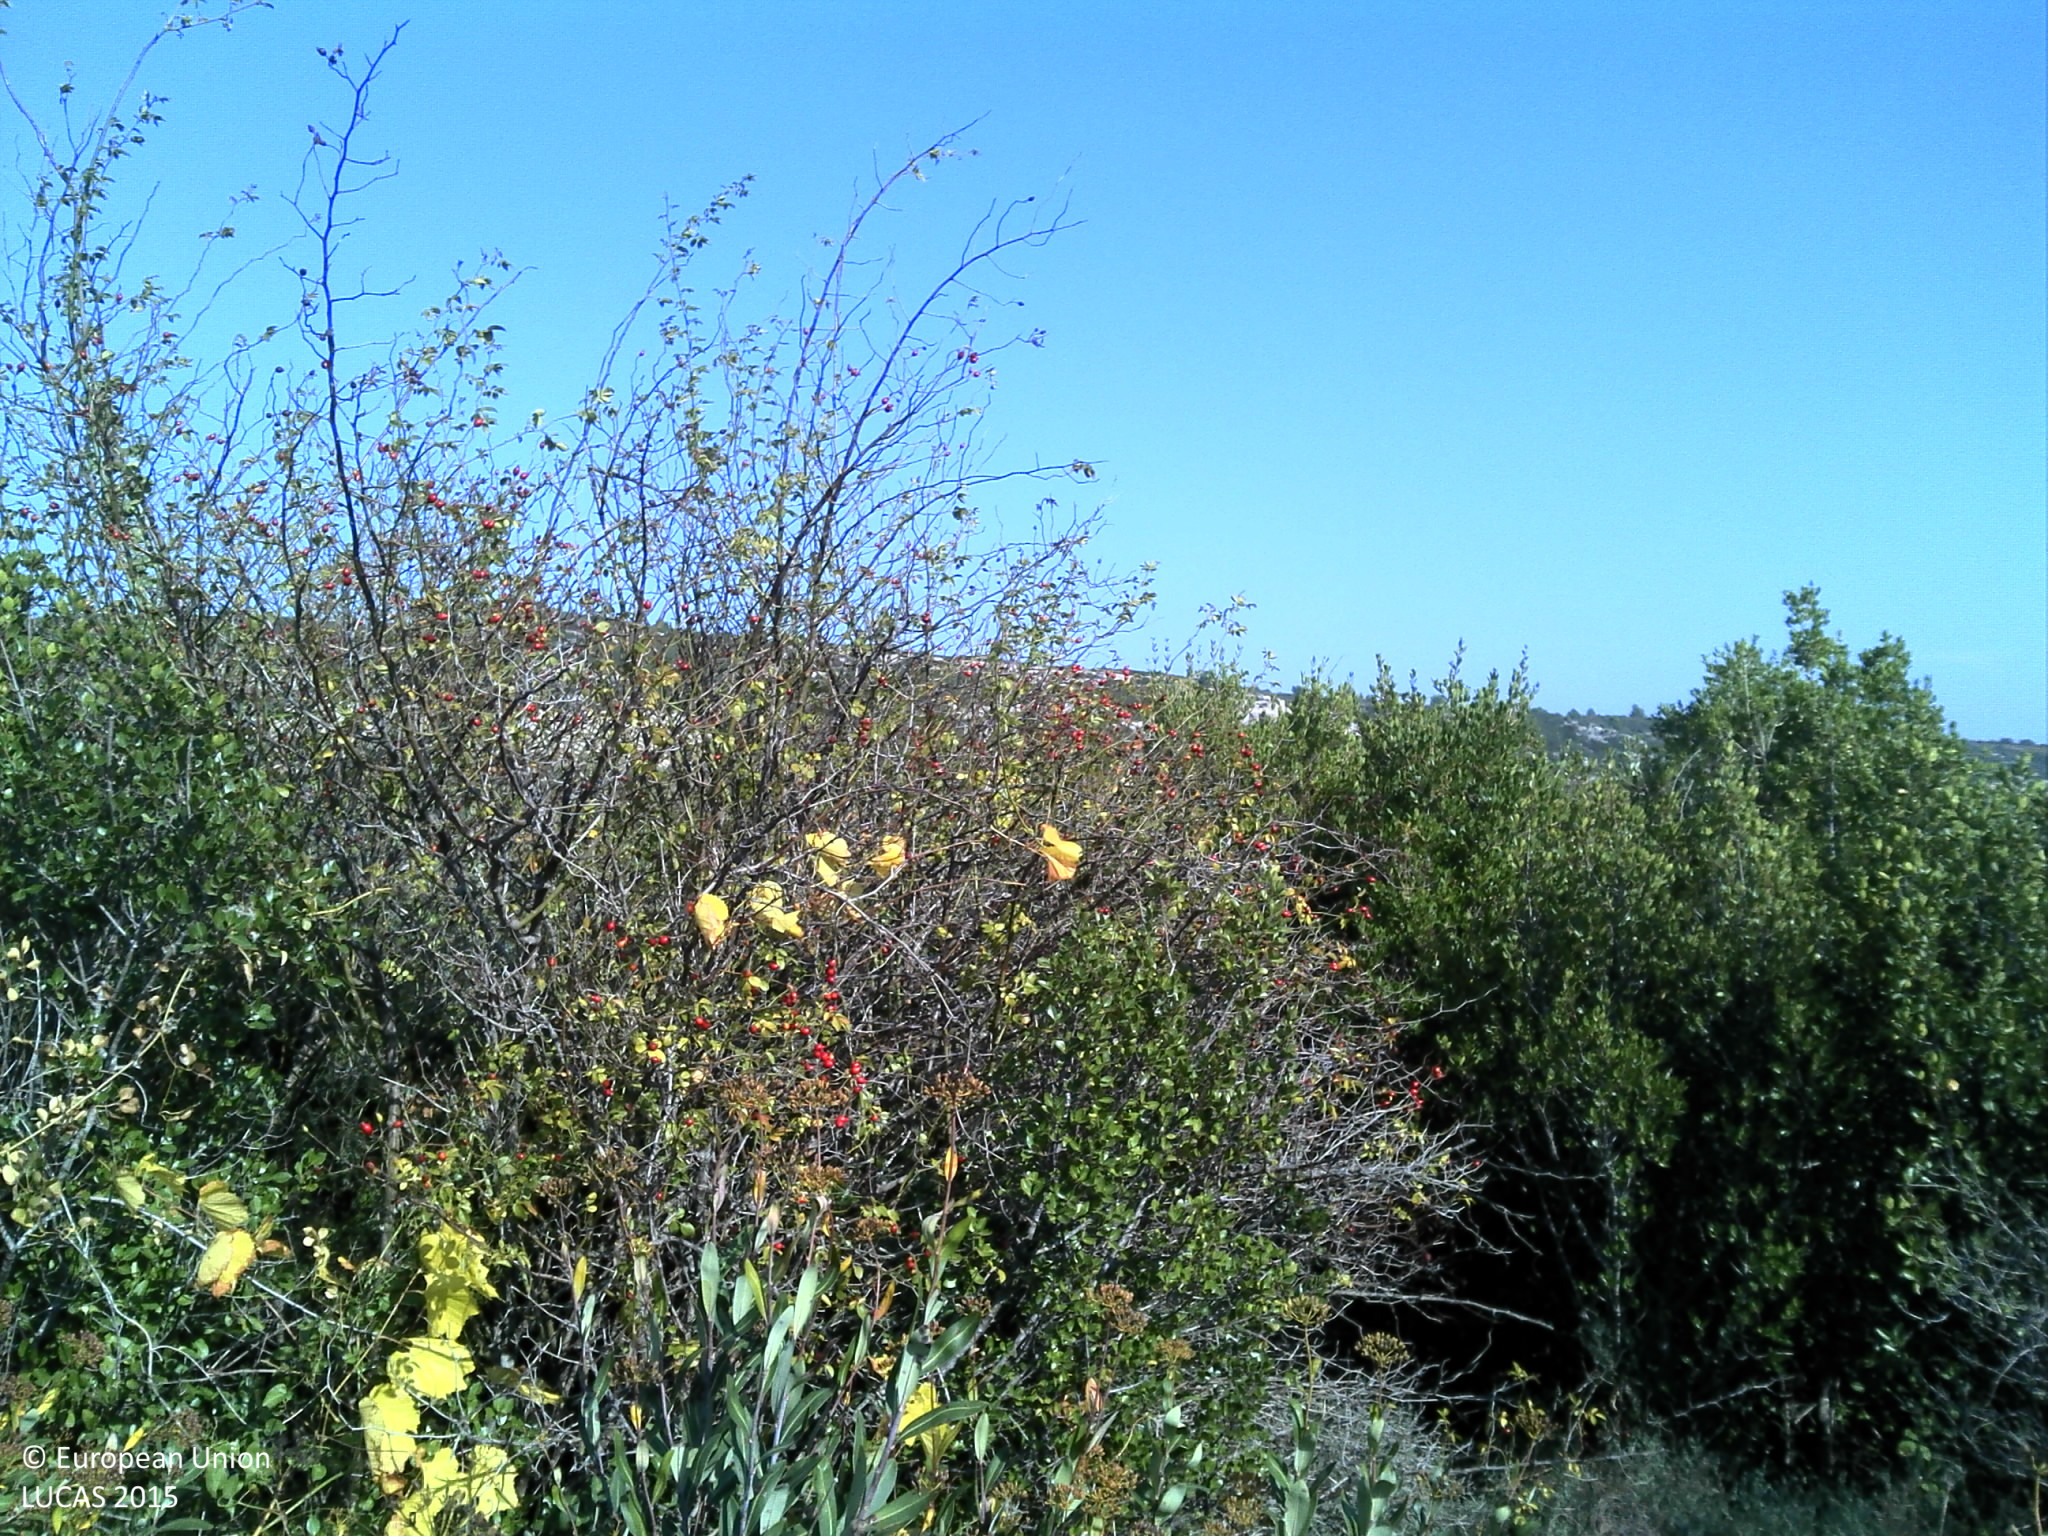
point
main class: Shrubland
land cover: Shrubland with sparse tree cover
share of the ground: > 75 %
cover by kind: shrubs 80 %, herbaceous plants 15 %, broadleaved forest trees 5 %
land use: Semi-natural and natural areas not in use
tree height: < 5 m
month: October
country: FR
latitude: 43.3555
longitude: 2.7660
